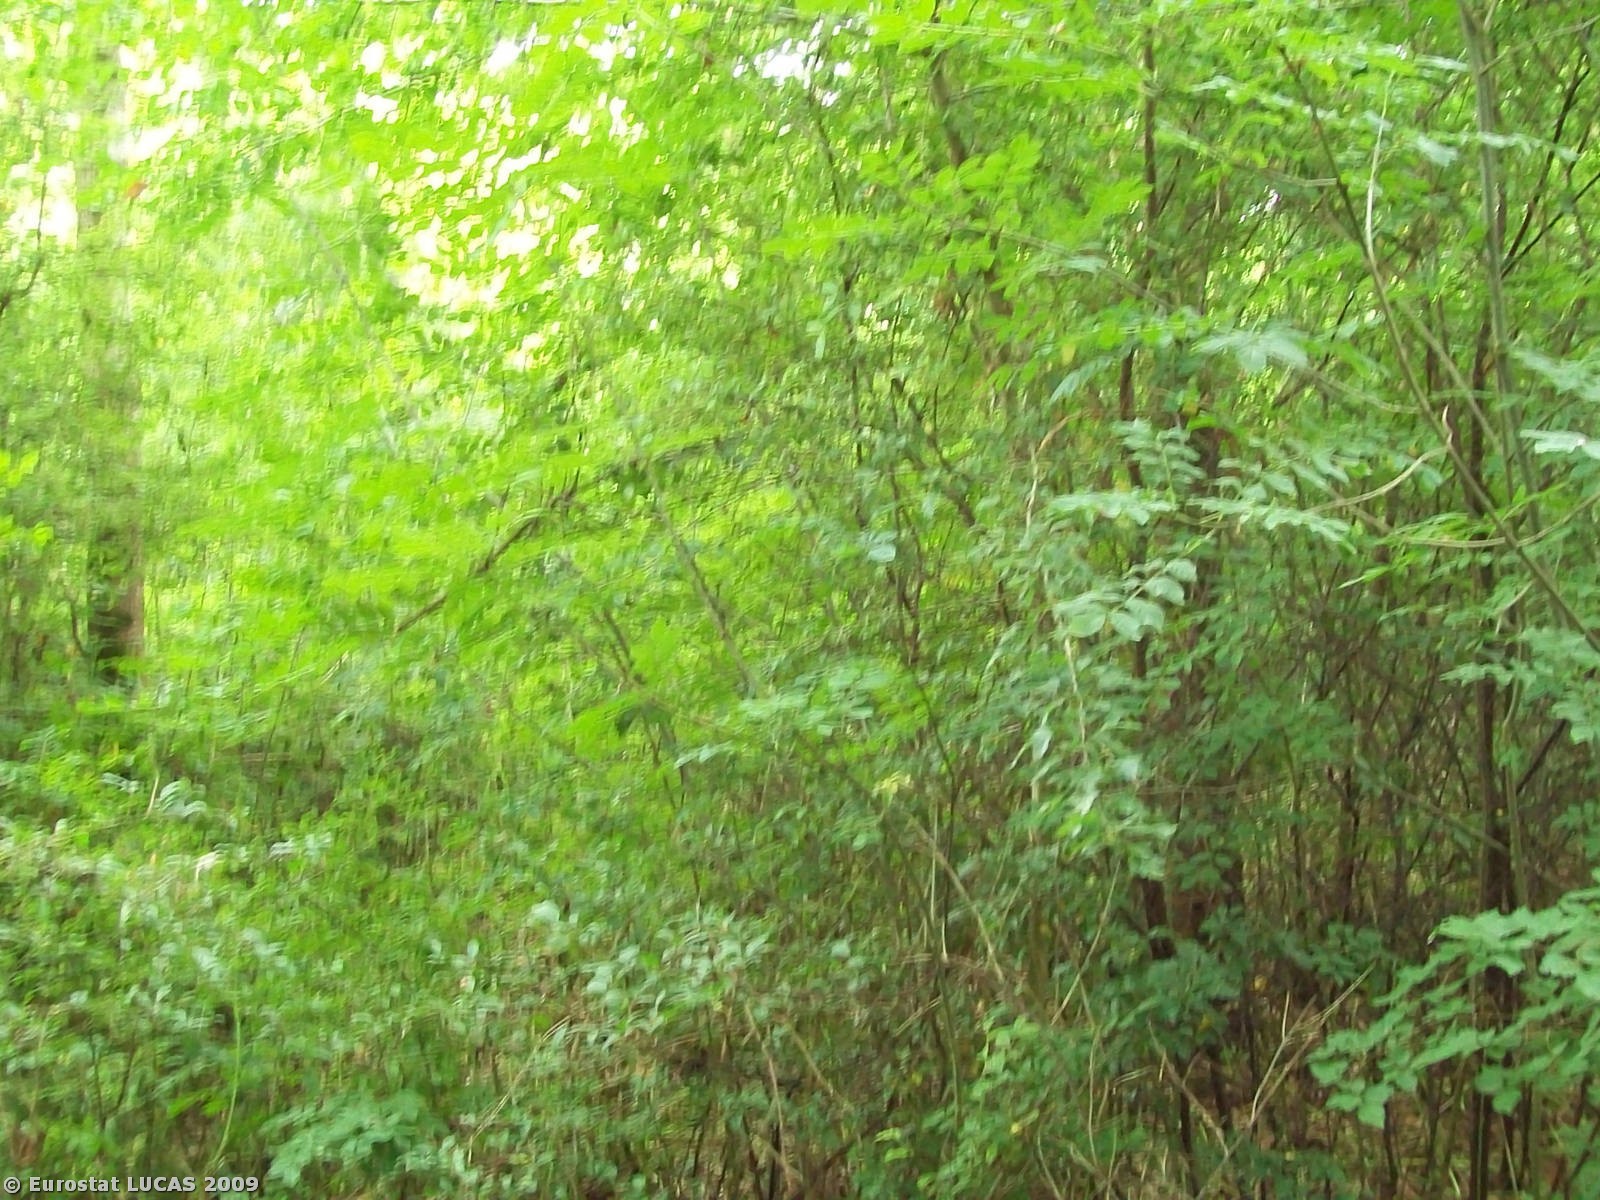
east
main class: Woodland
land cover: Broadleaved woodland
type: mesophytic deciduous forest
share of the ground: > 75 %
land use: Forestry
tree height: > 5 m
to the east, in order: Broadleaved woodland; Grass margins; Tracks; Grass margins; Fences; Broadleaved woodland; Inland running water; Spontaneously vegetated surfaces; Arable land (only in case pi)
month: June
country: GB
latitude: 51.3429
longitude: -2.2215
